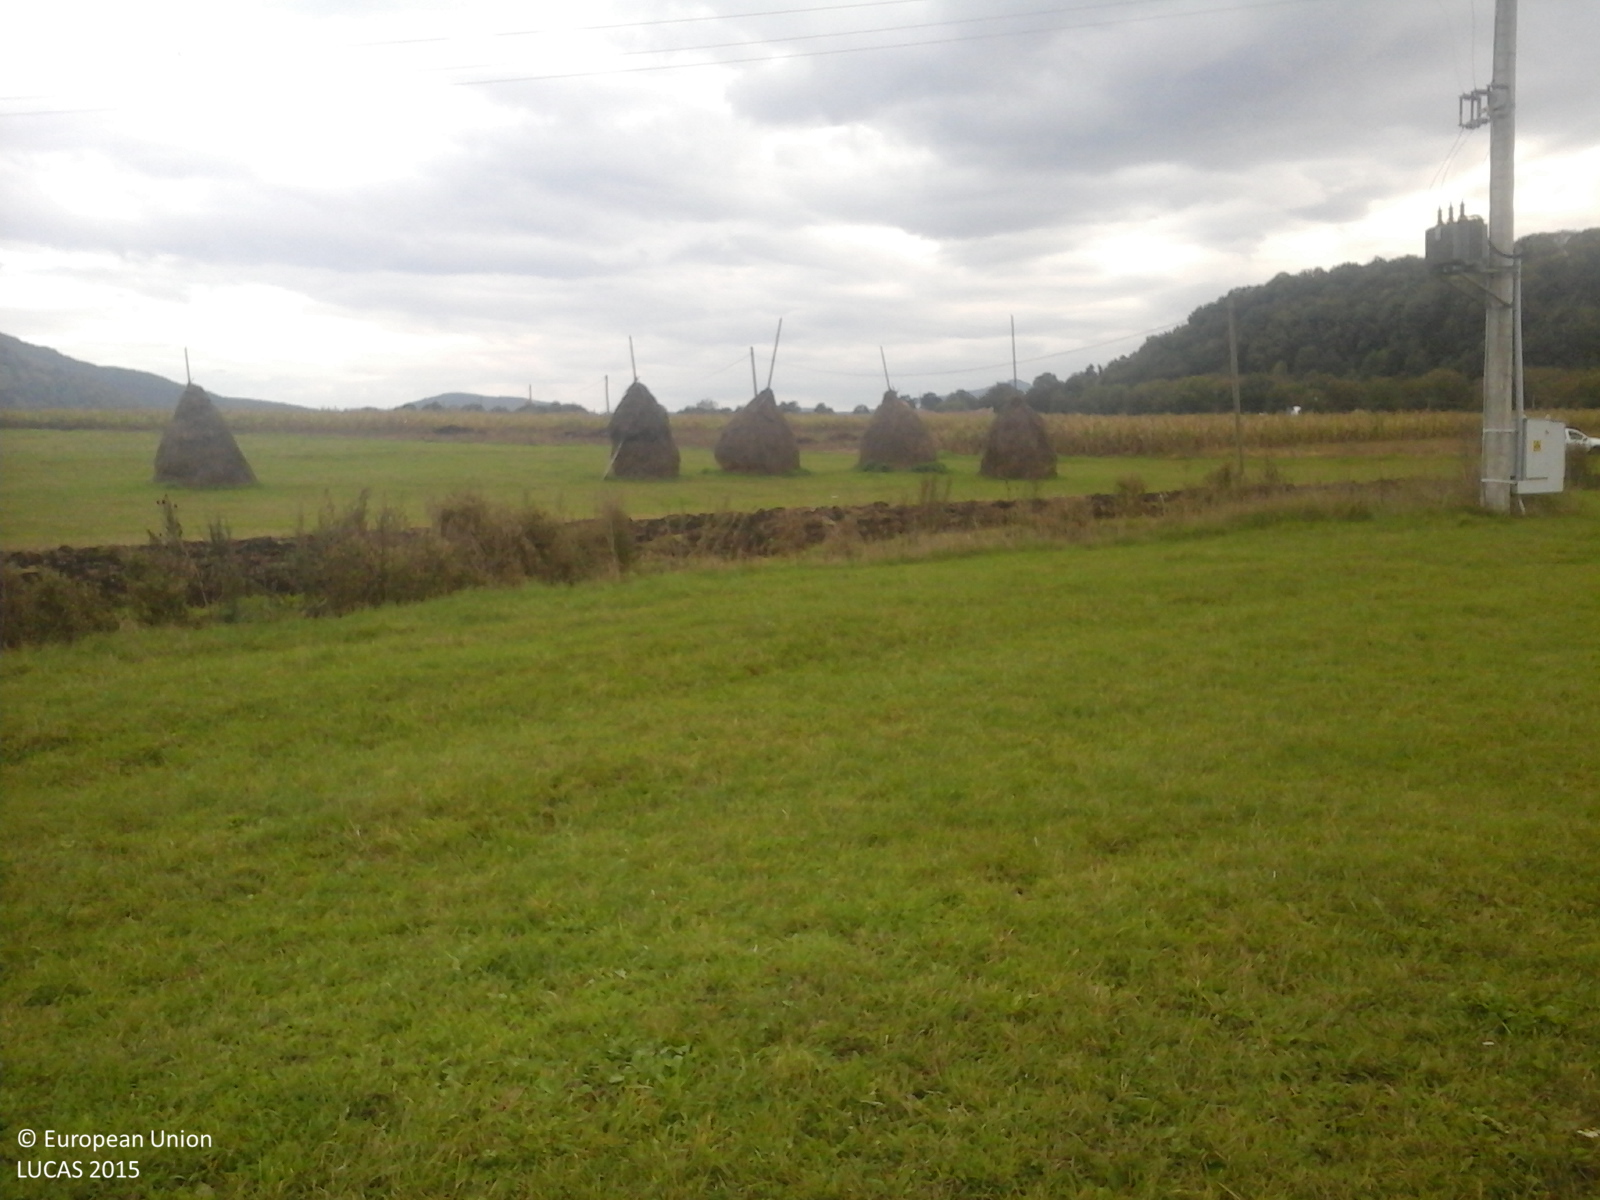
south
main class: Grassland
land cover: Grassland without tree/shrub cover
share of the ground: > 75 %
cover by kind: herbaceous plants 100 %
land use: Agriculture (excluding fallow land and kitchen gardens)
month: October
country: RO
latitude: 46.4315
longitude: 23.5639
